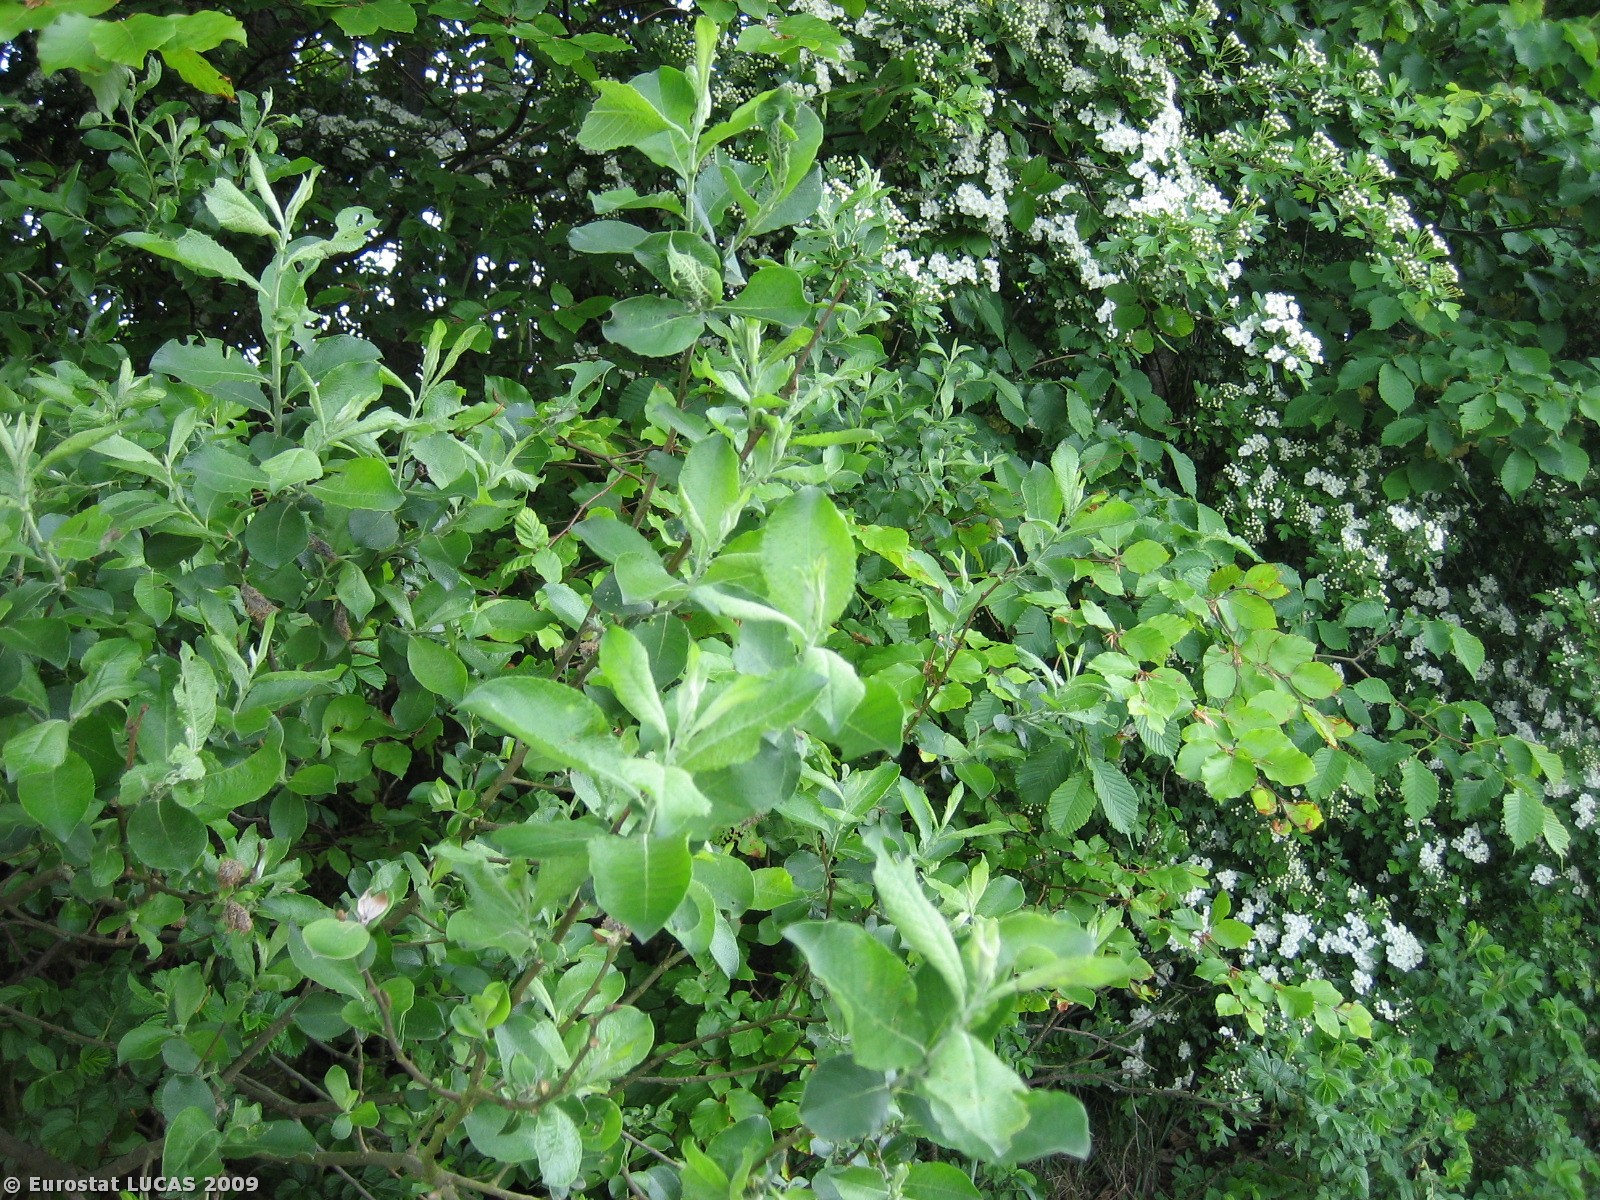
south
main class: Woodland
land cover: Broadleaved woodland
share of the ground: > 75 %
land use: Unused
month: May
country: DK
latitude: 56.2911
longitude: 8.9188
